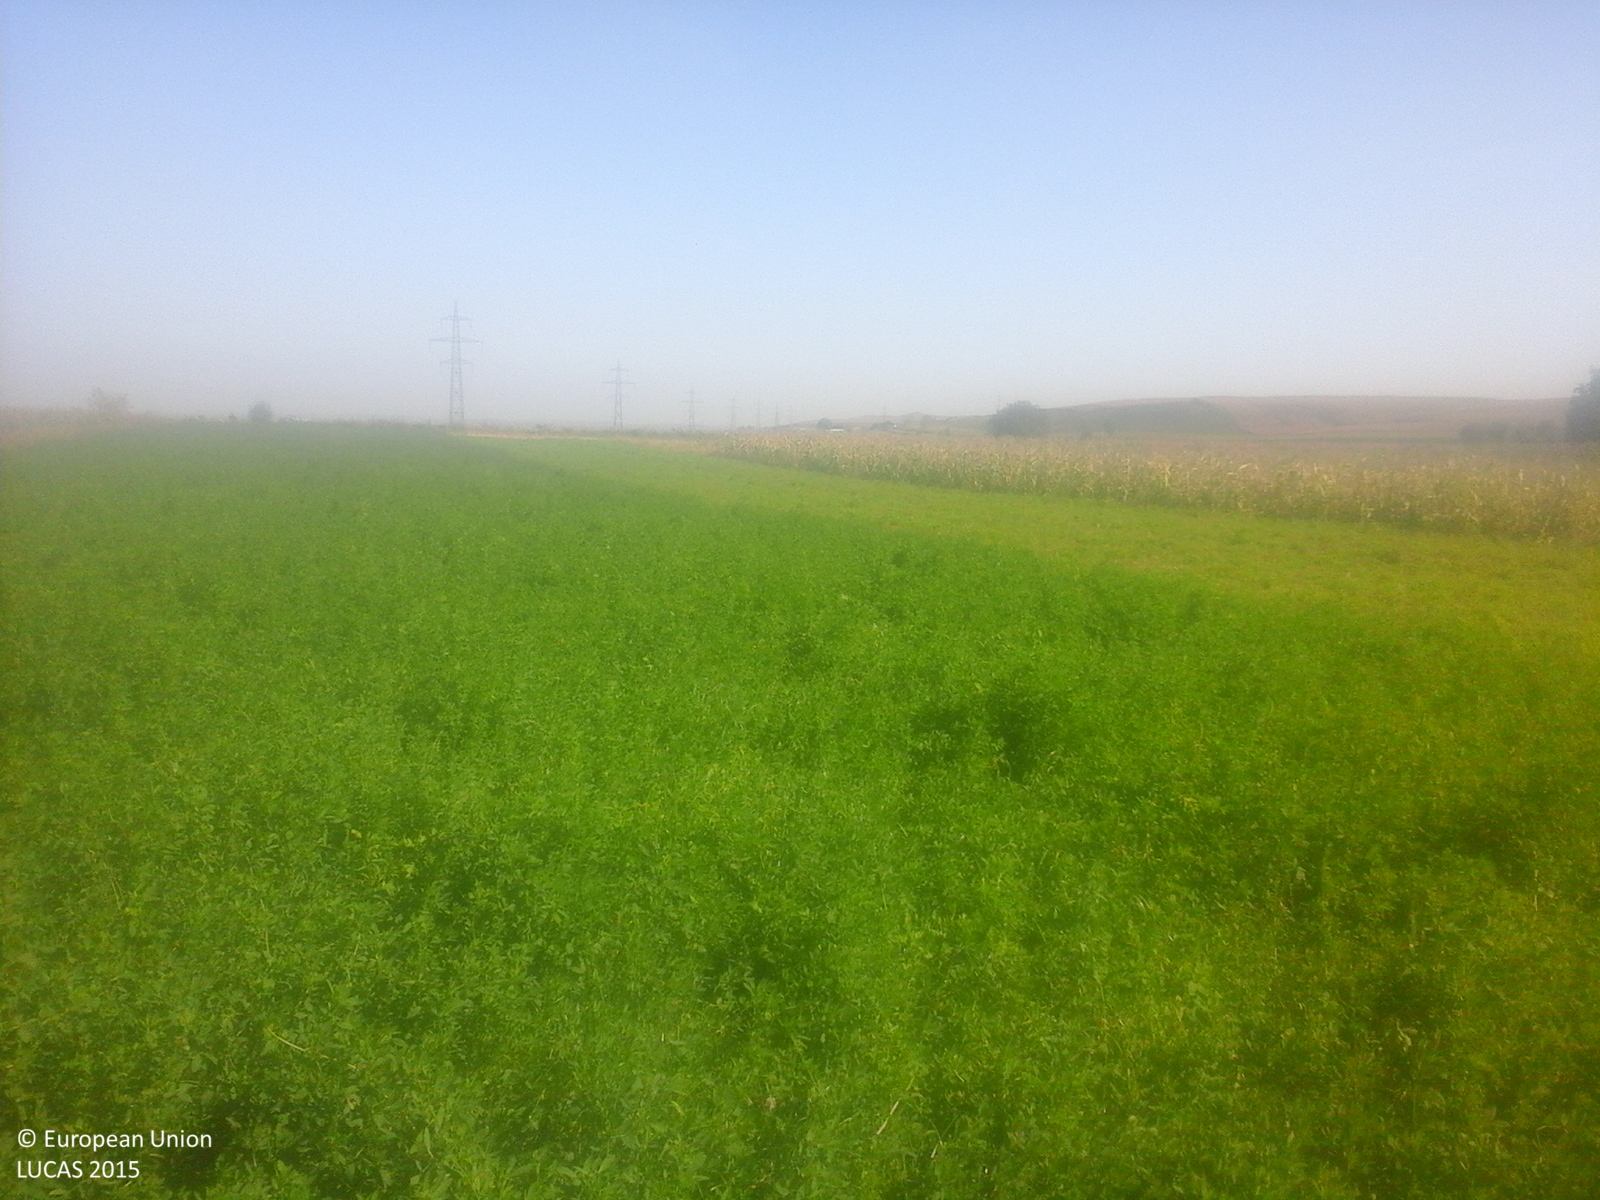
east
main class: Cropland
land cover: Lucerne
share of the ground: > 75 %
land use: Agriculture (excluding fallow land and kitchen gardens)
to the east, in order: Lucerne; Maize; Spontaneously vegetated surfaces; Tomatoes; Lucerne; Shruby margins; Ditches and canals; Shruby margins; Tracks; Shruby margins; Maize; Tracks; Lucerne; Other fresh vegetables
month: October
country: RO
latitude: 46.5034
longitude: 23.7151
